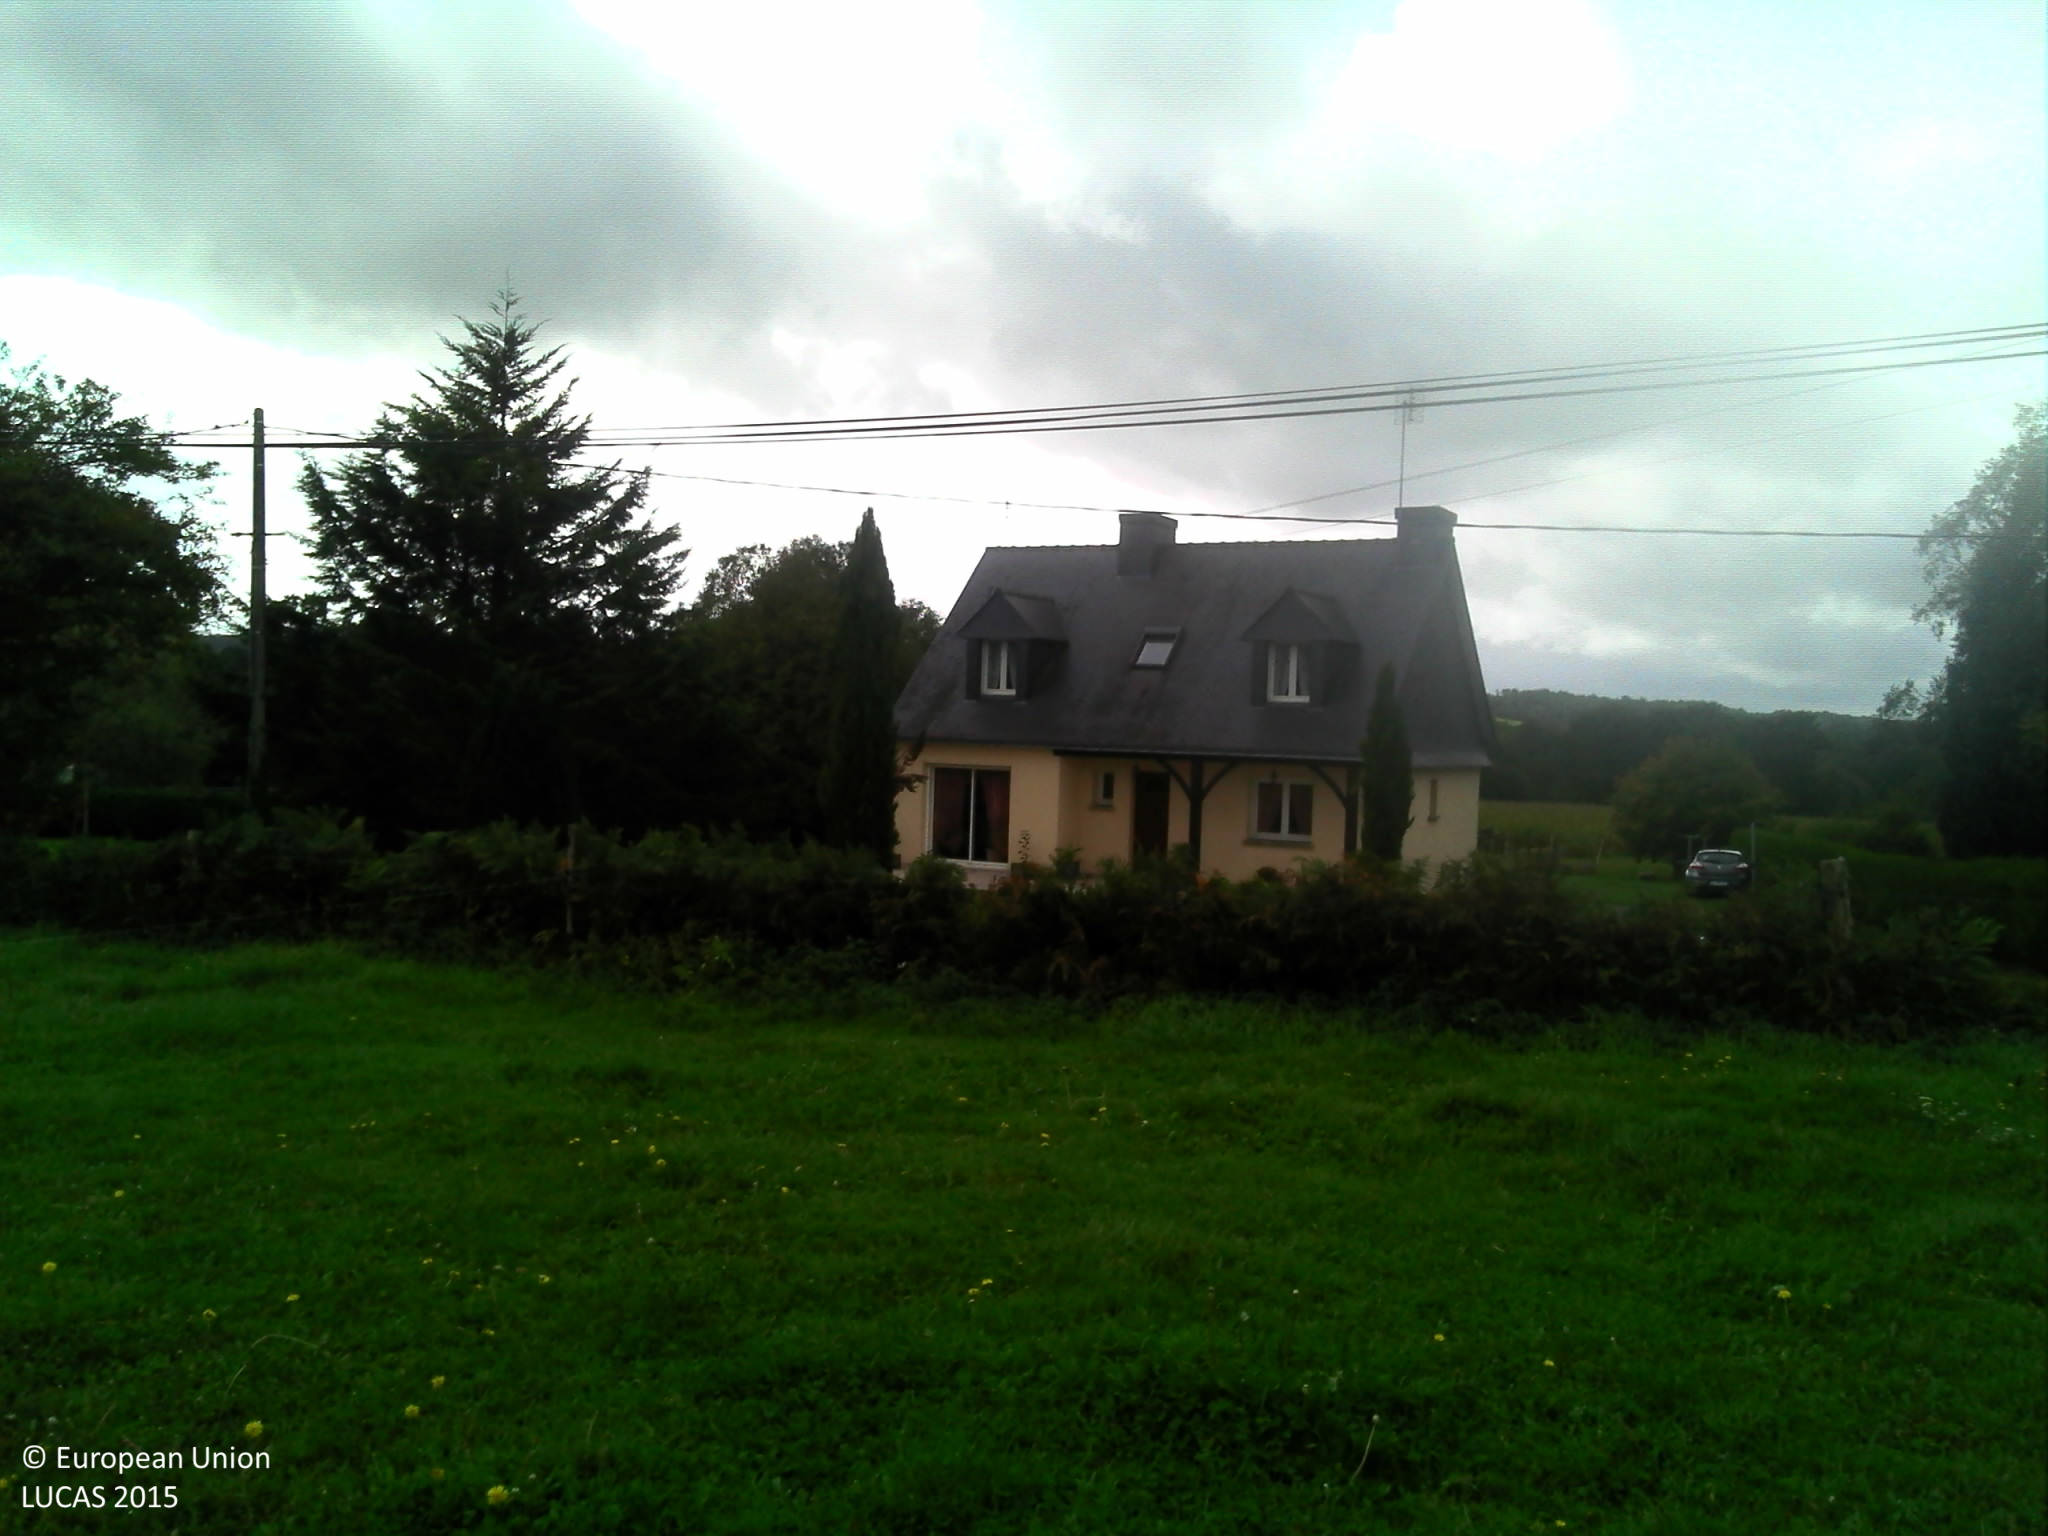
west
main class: Grassland
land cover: Grassland without tree/shrub cover
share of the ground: > 75 %
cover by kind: herbaceous plants 100 %
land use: Agriculture (excluding fallow land and kitchen gardens)
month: October
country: FR
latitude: 47.7959
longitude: -2.2162
